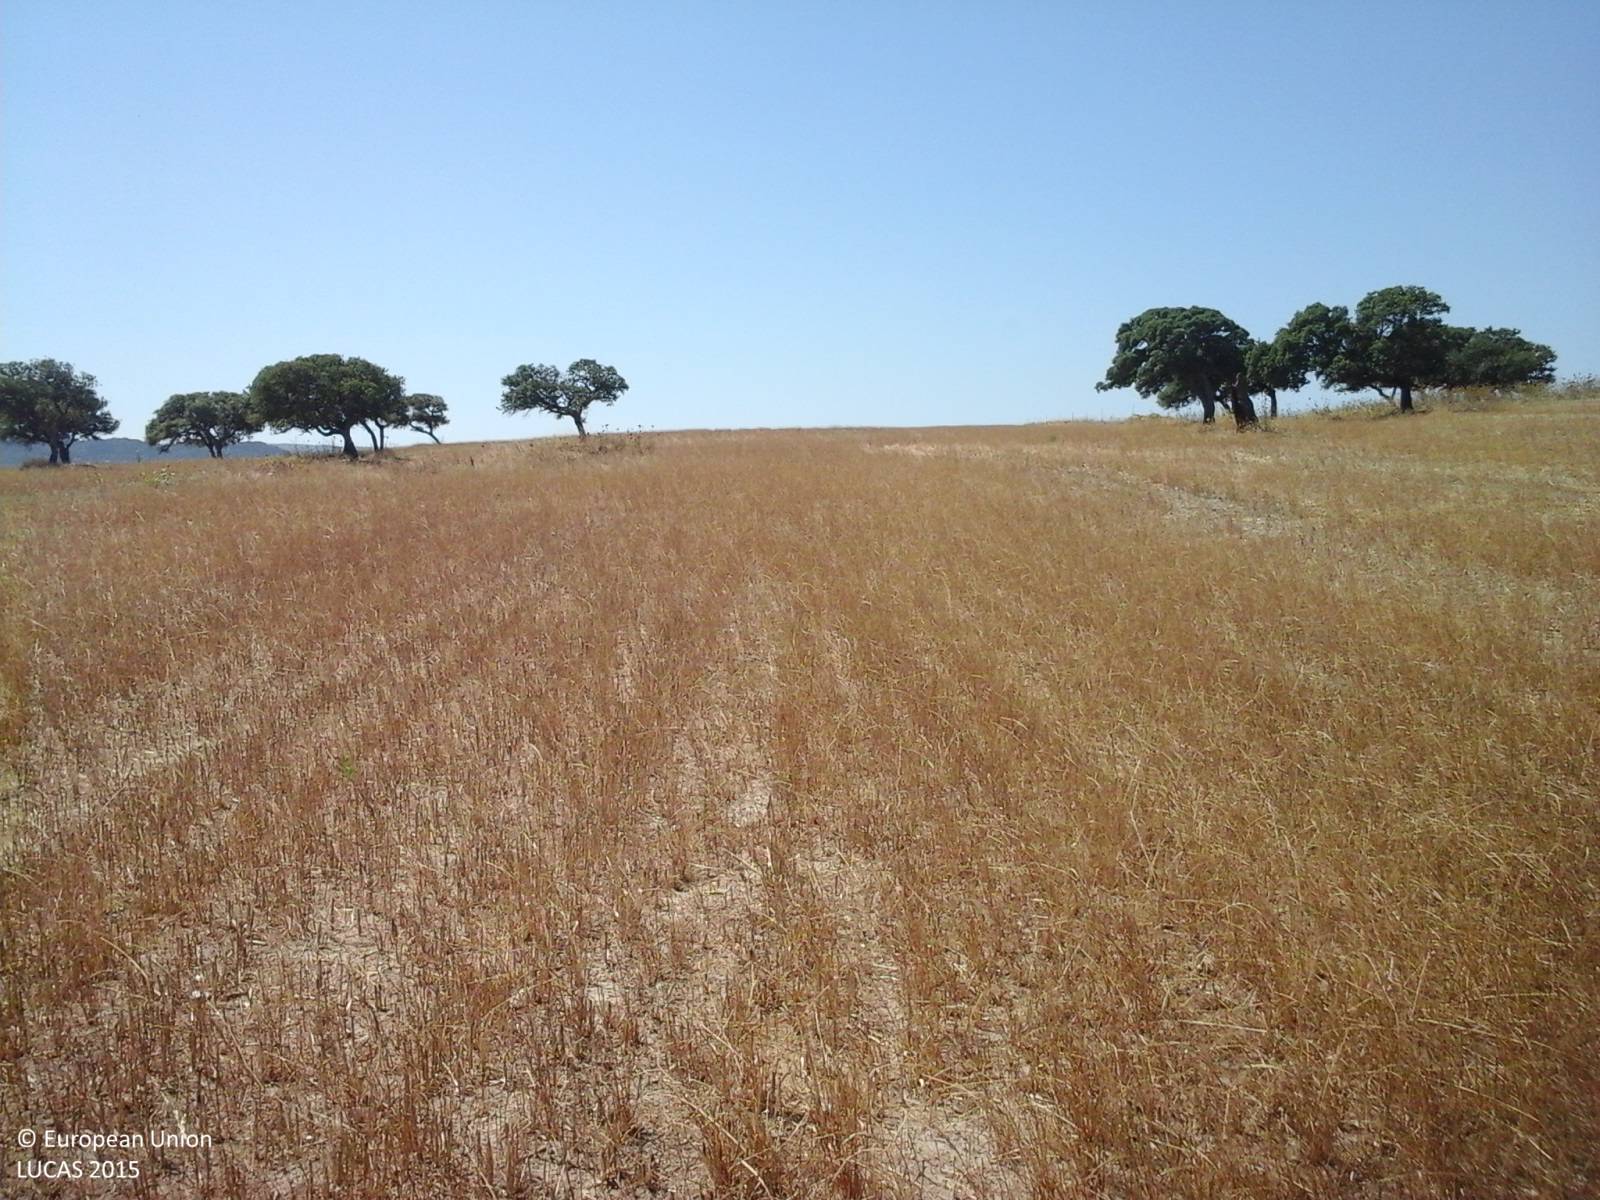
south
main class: Cropland
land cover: Oats
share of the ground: < 10 %
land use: Agriculture (excluding fallow land and kitchen gardens)
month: July
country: IT
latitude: 40.5871
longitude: 8.9066
